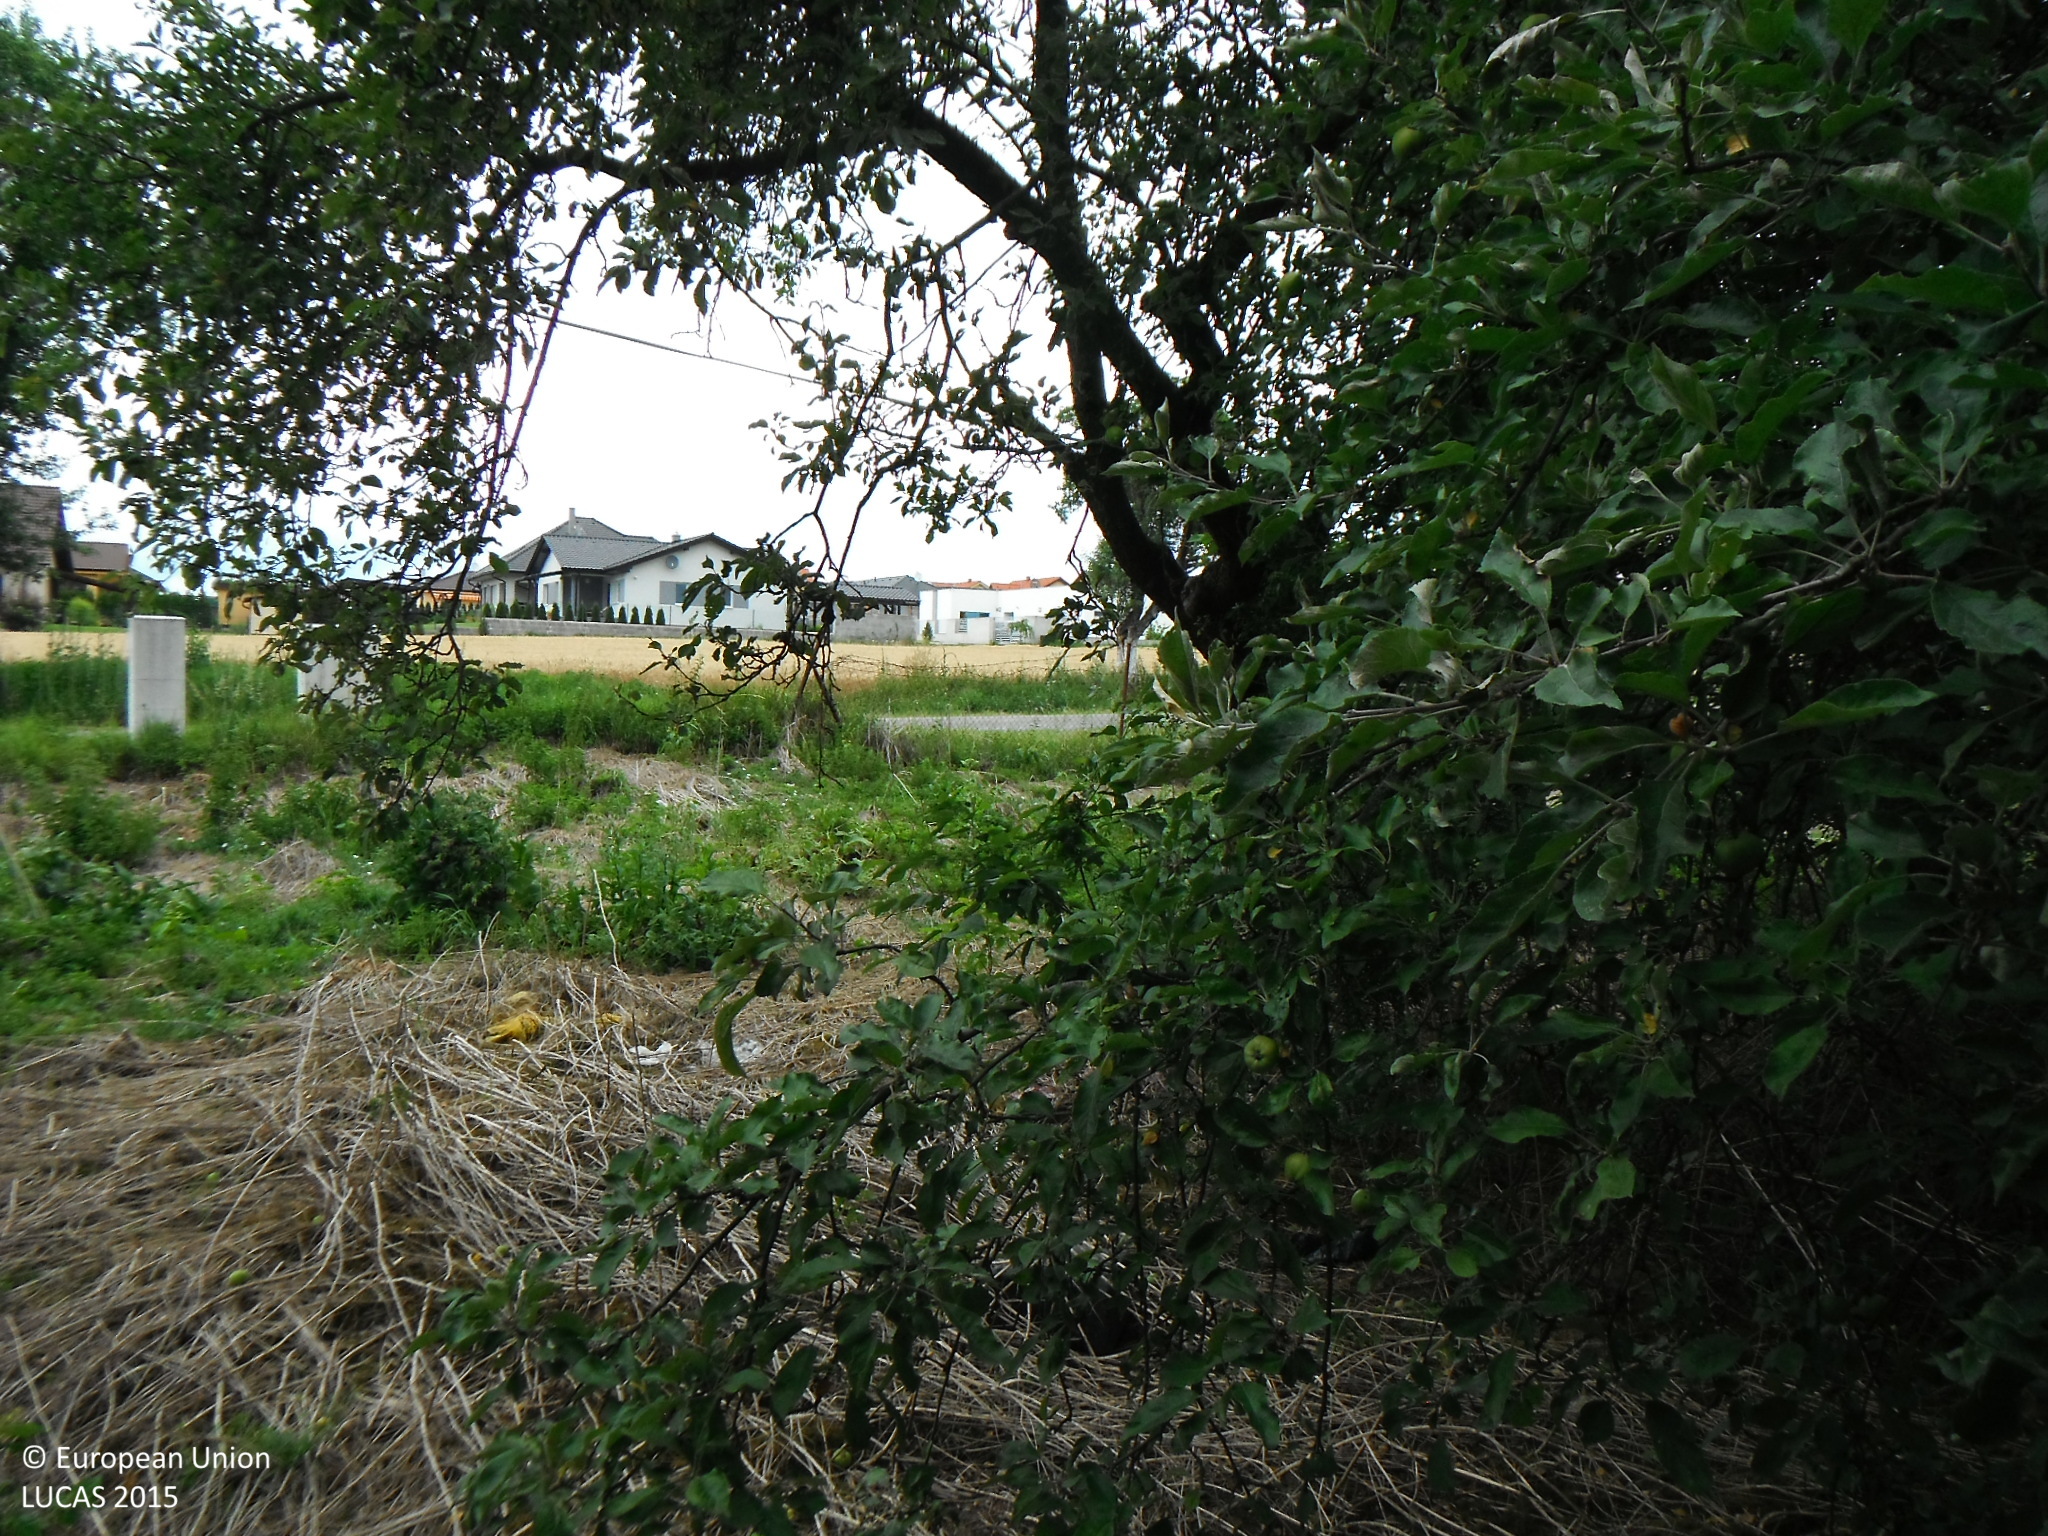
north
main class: Cropland
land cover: Nuts trees
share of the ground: 50 - 75 %
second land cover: Grassland without tree/shrub cover
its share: > 75 %
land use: Kitchen garden
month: July
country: SK
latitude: 48.7821
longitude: 21.3278
